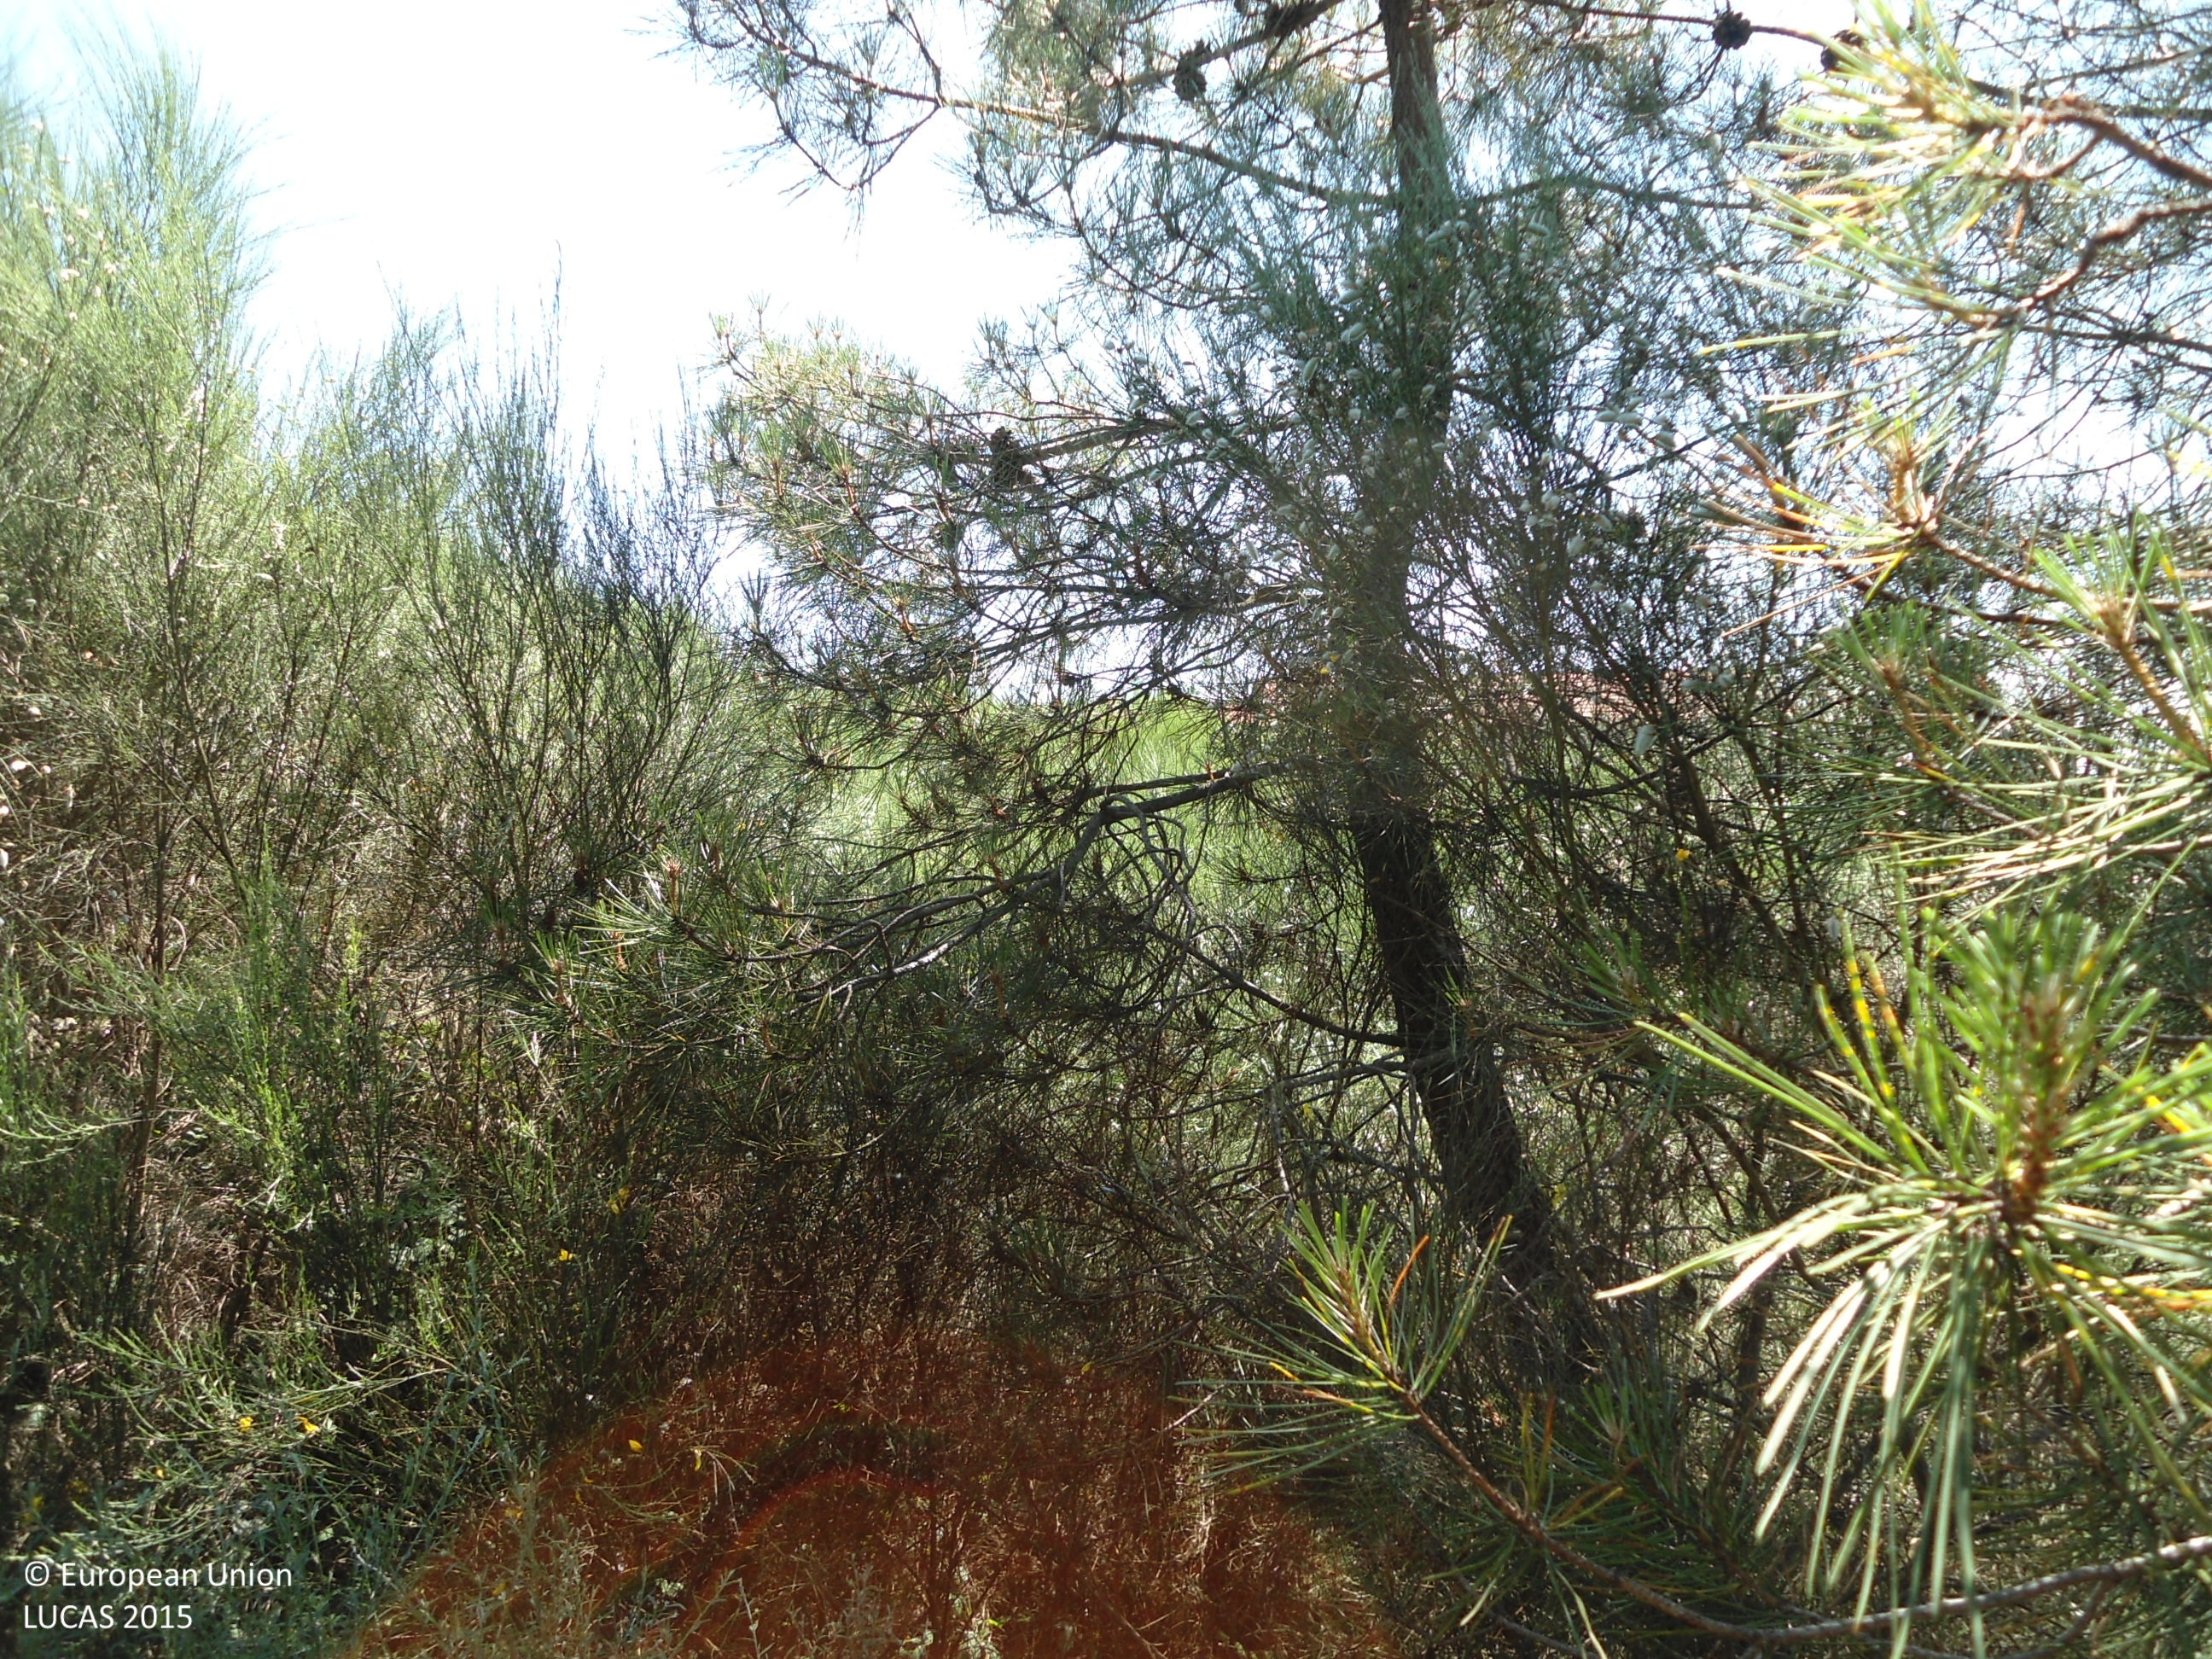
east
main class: Woodland
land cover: Pine dominated coniferous woodland
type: coniferous forest of the mediterranean region
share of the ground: 25 - 50 %
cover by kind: shrubs 70 %, coniferous forest trees 30 %
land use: Forestry
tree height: > 5 m
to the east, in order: Pine dominated coniferous woodland; Shrubland without tree cover; Grassland without tree/shrub cover; Tracks; Grass margins; Potatoes; Grass margins; Tracks; Paved roads, cycling and walking lanes; Grass margins; Electric lines; Grass margins; Dry stone walls; Artificial constructions in urban areas; Other bare soil; Grassland without tree/shrub cover
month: June
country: ES
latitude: 41.9146
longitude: -7.2598
